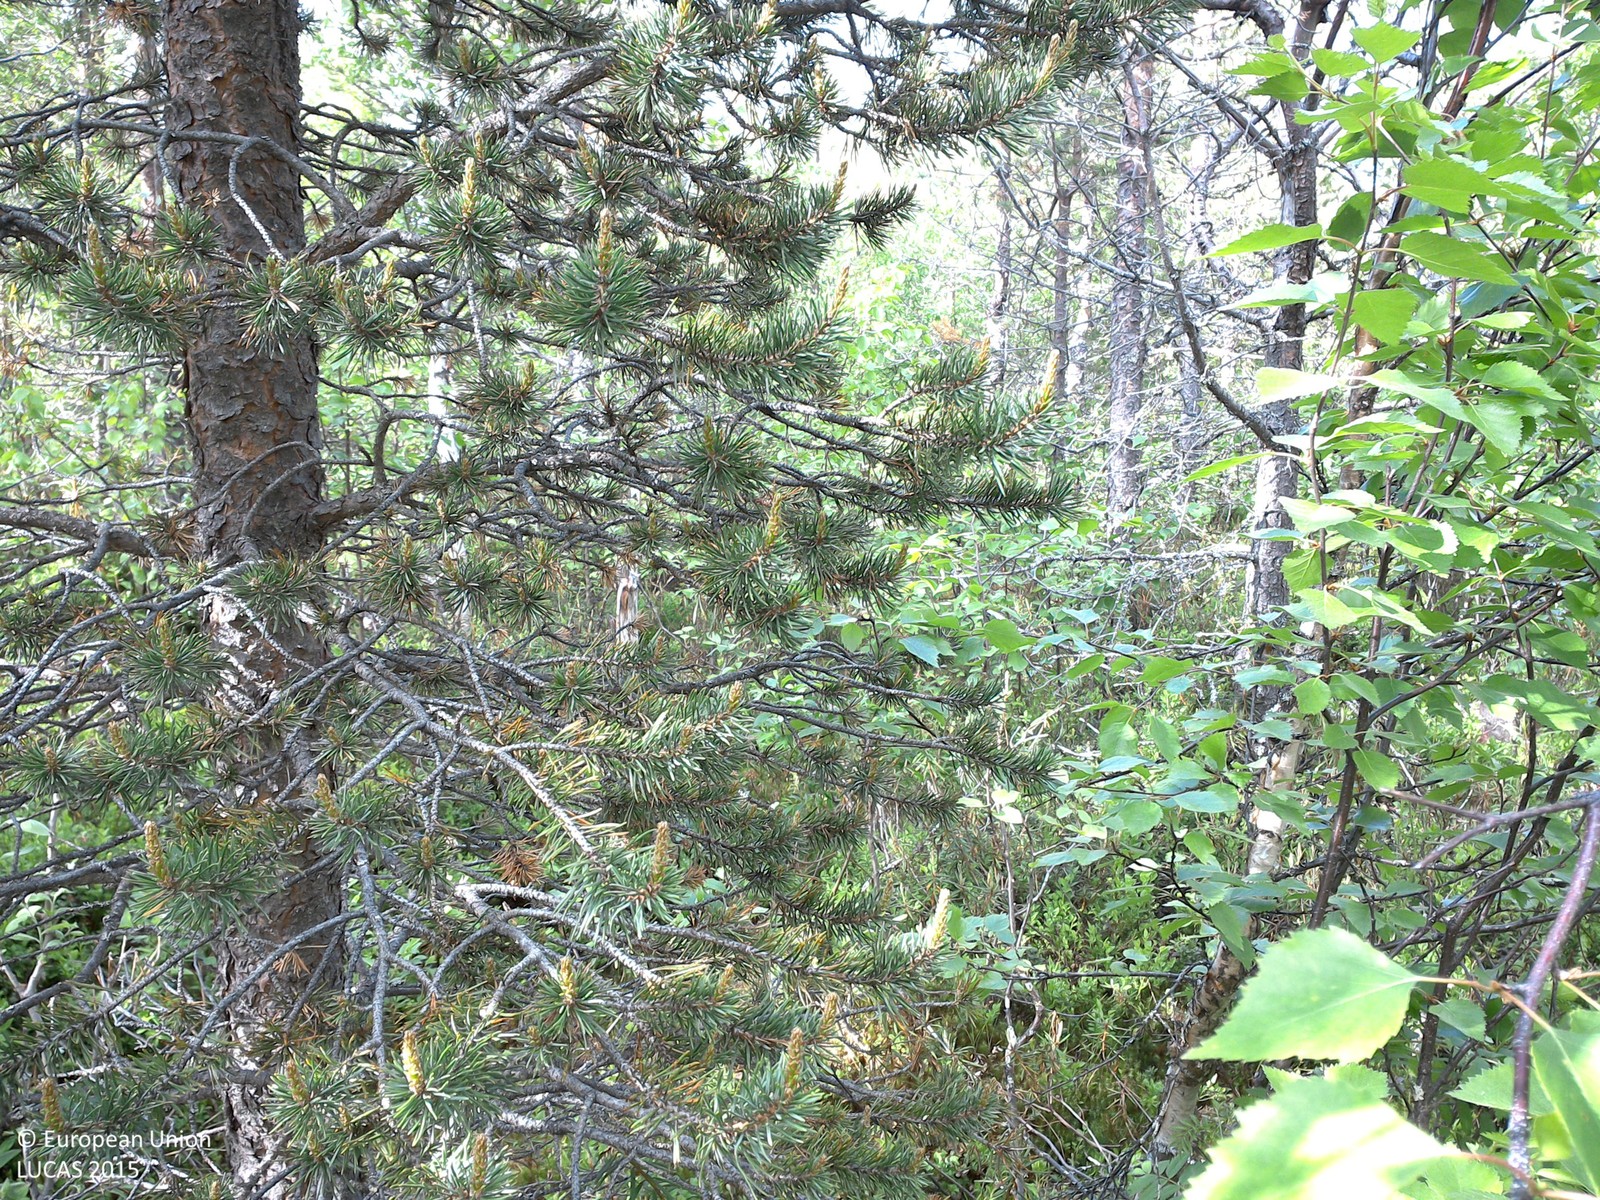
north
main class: Woodland
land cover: Pine dominated mixed woodland
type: boreal forest
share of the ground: 25 - 50 %
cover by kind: shrubs 45 %, coniferous forest trees 30 %, broadleaved forest trees 15 %, herbaceous plants 5 %
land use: Forestry
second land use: Amenities, museums, leisure
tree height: > 5 m
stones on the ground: < 10 %
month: June
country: SE
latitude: 66.6418
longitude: 22.9259
